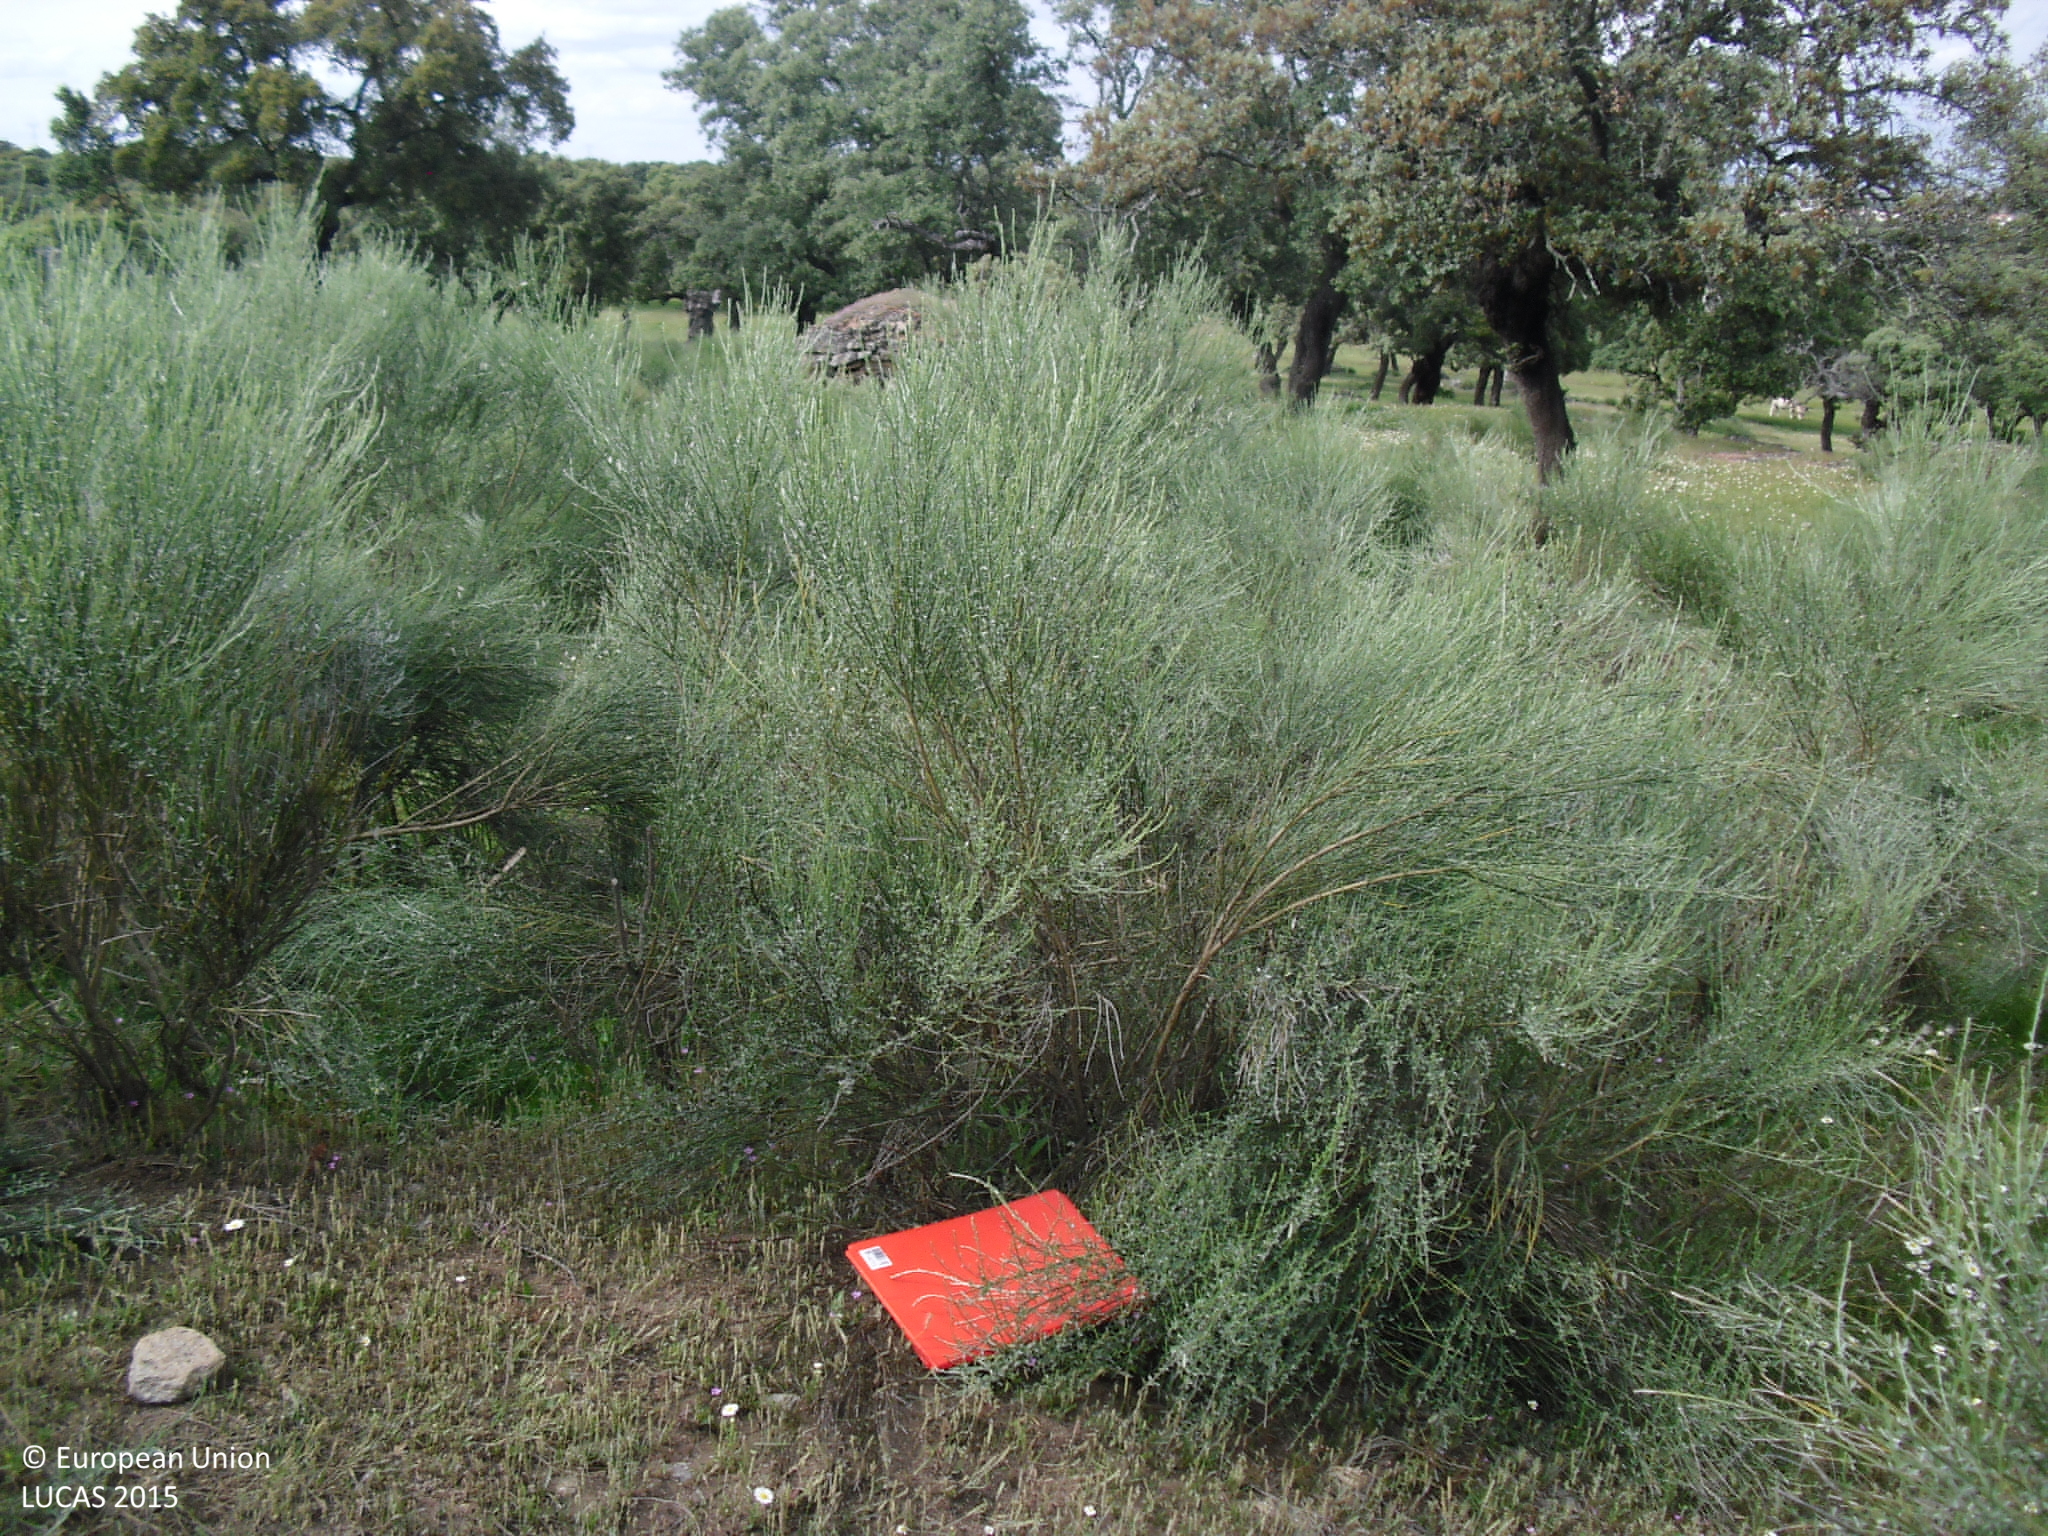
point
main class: Shrubland
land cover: Shrubland with sparse tree cover
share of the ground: > 75 %
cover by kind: shrubs 75 %, herbaceous plants 20 %, broadleaved forest trees 5 %
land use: Agriculture (excluding fallow land and kitchen gardens)
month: April
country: ES
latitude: 39.2942
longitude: -6.0005
